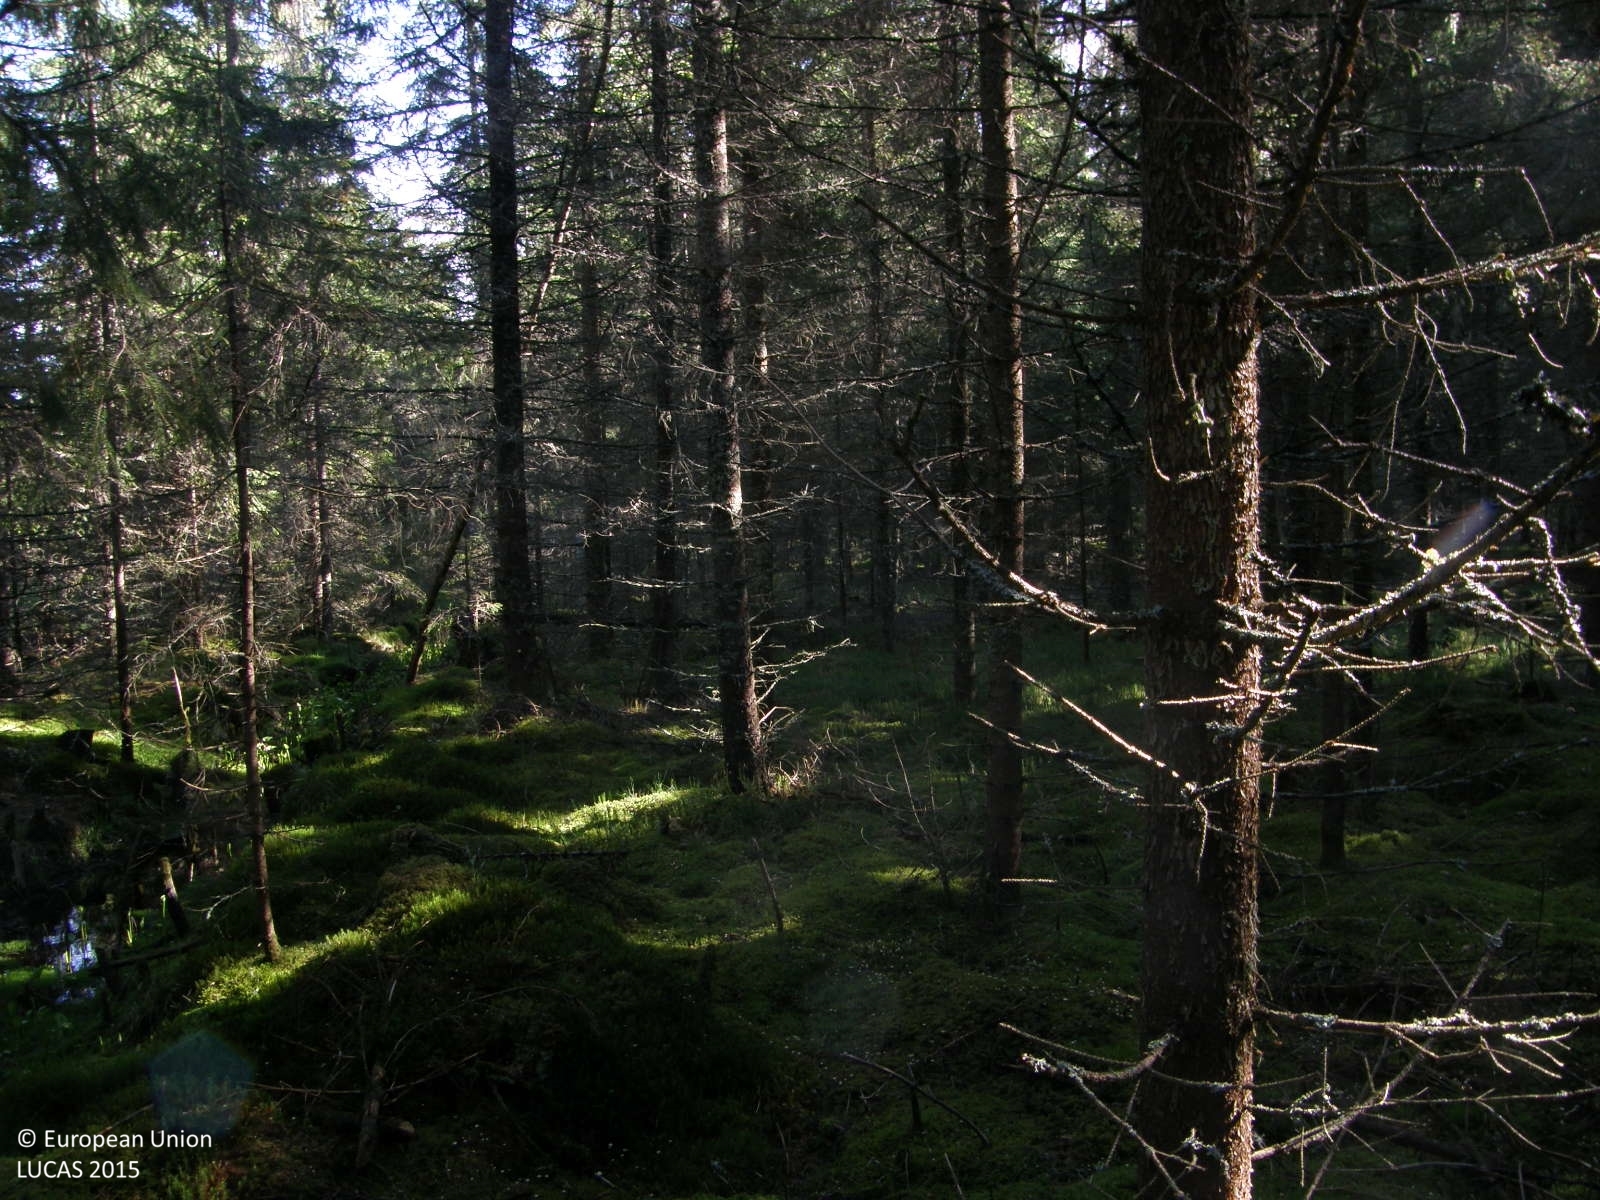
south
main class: Woodland
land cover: Spruce dominated coniferous woodland
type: boreal forest
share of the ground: > 75 %
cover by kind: coniferous forest trees 95 %, lichens and mosses 5 %
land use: Forestry
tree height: > 5 m
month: June
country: FI
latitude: 61.9539
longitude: 21.6983
